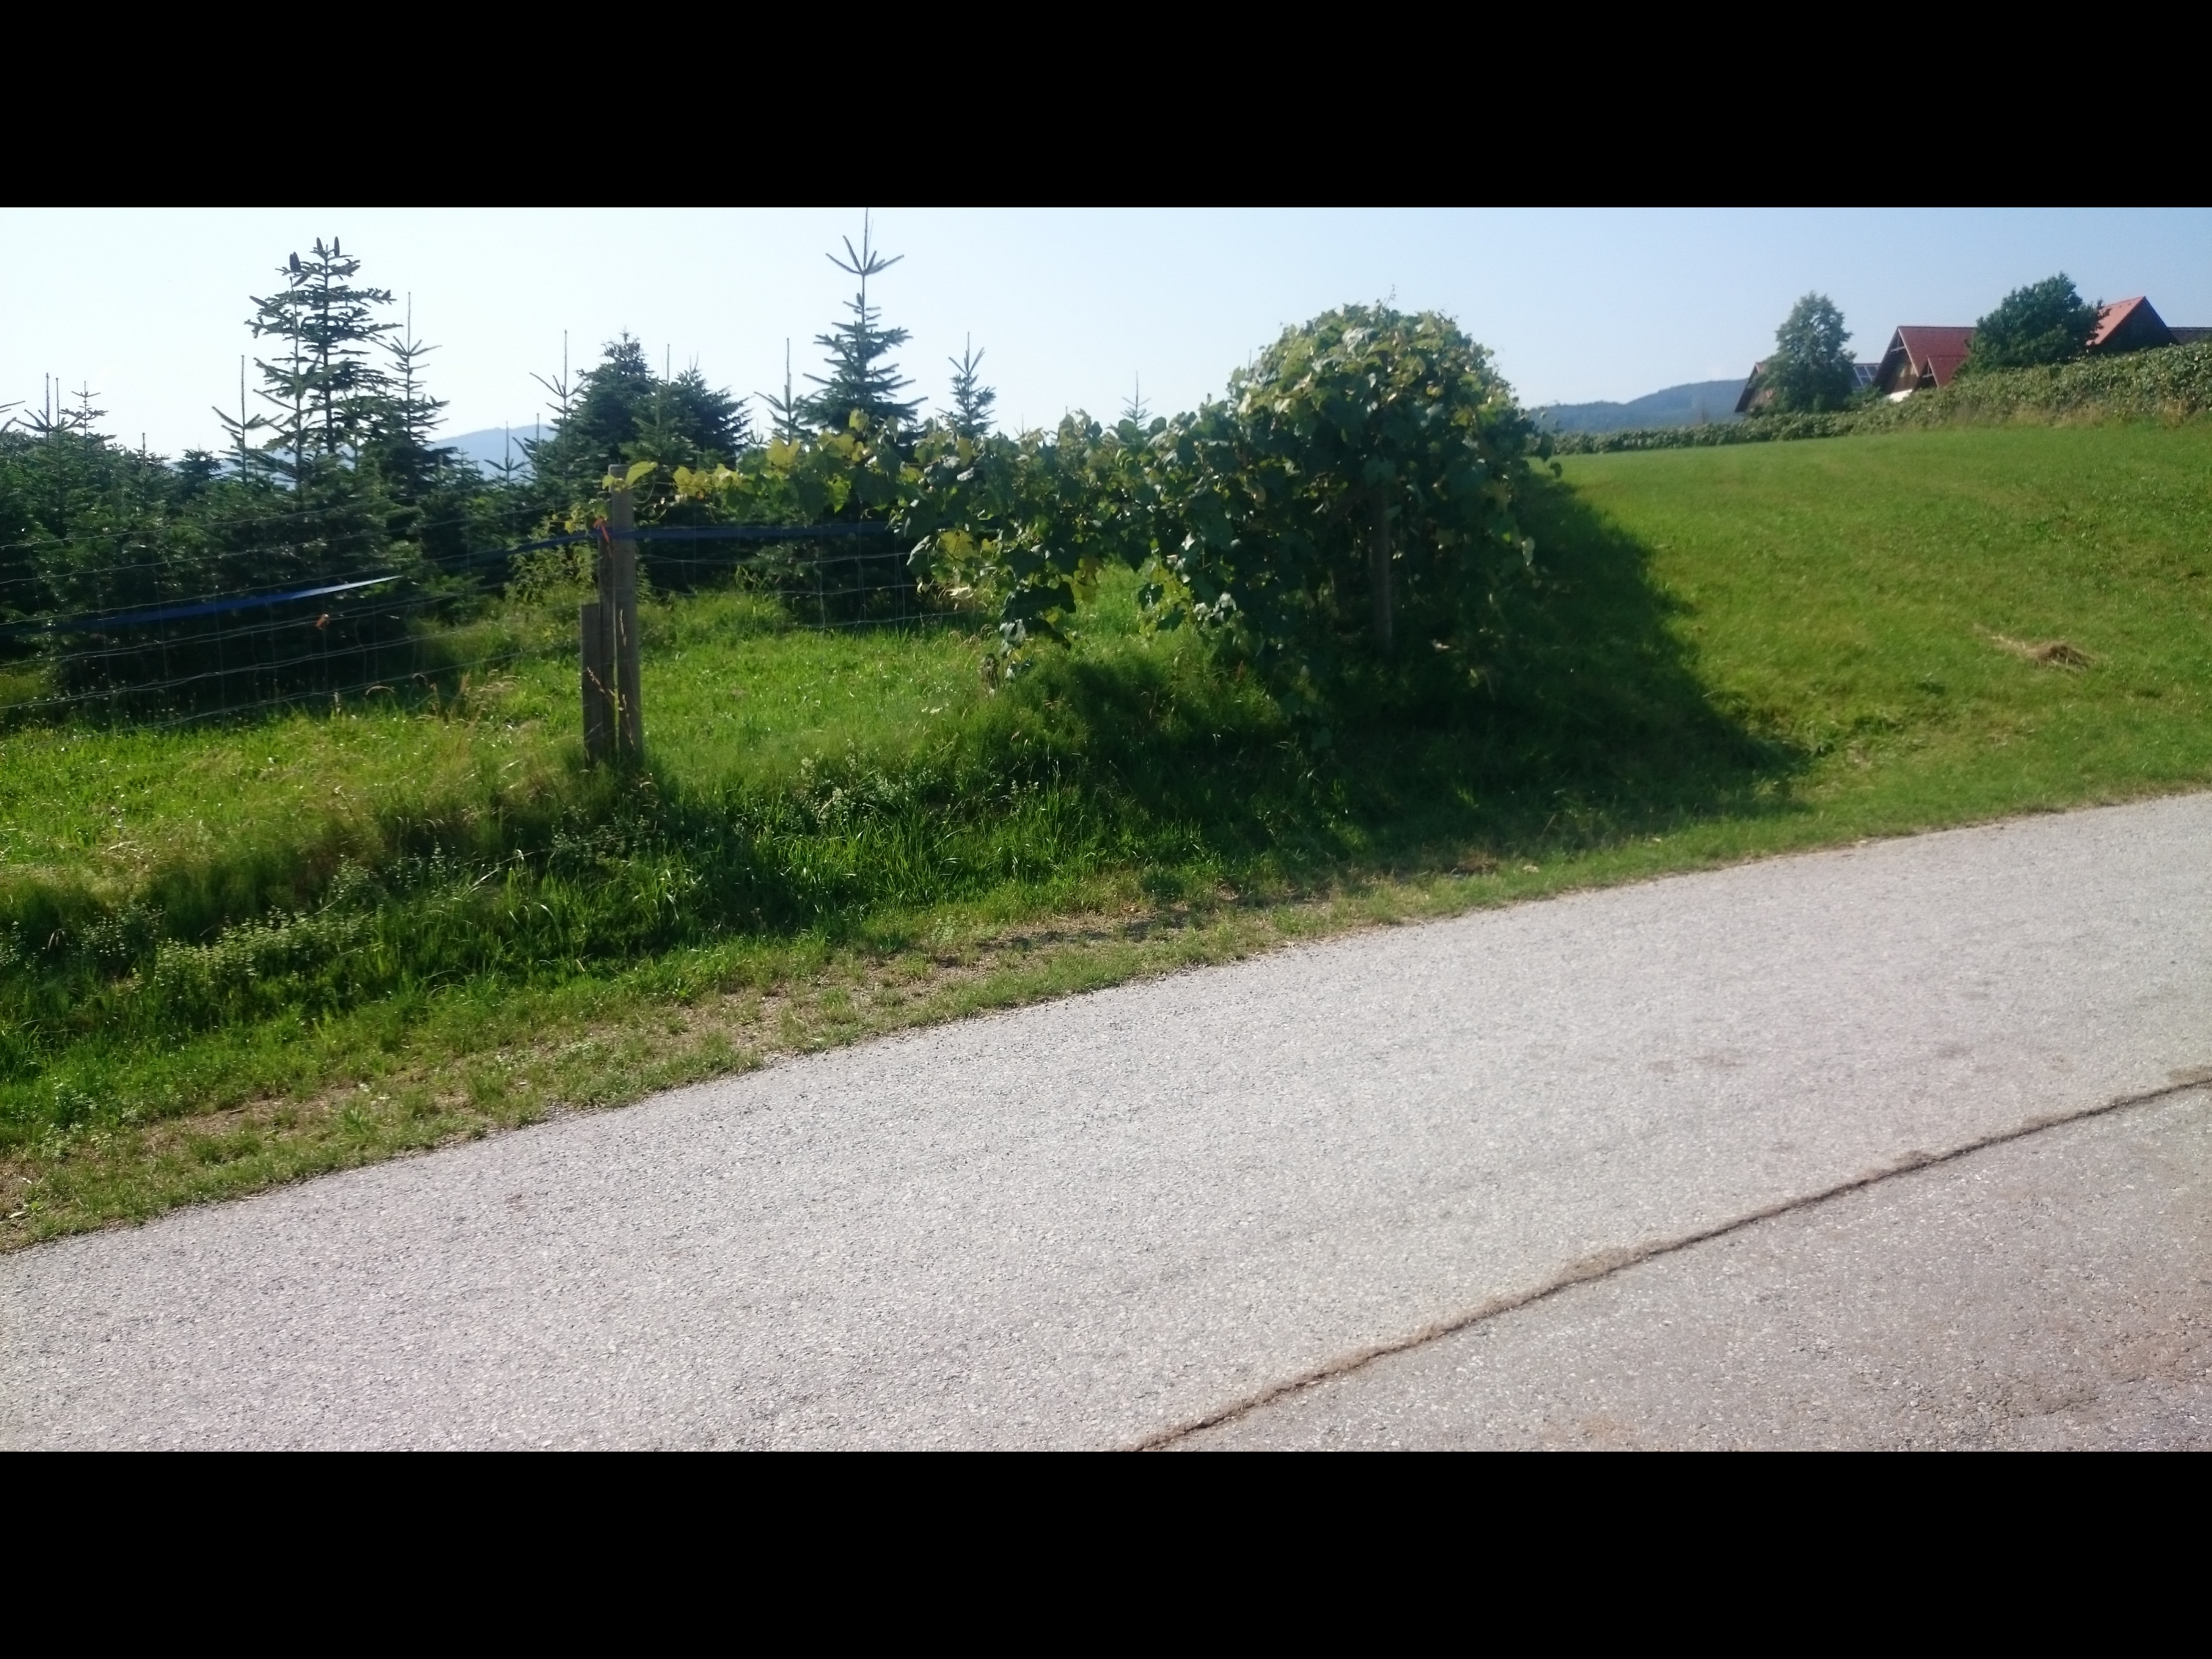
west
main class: Woodland
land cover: Other coniferous woodland
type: hemiboreal forest and nemoral coniferous forest and mixed broadleaved-coniferous forest
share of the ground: 50 - 75 %
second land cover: Grassland without tree/shrub cover
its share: 25 - 50 %
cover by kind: coniferous forest trees 55 %, herbaceous plants 45 %
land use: Forestry
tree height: < 5 m
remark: Nursery
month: July
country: AT
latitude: 47.2146
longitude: 15.6122
